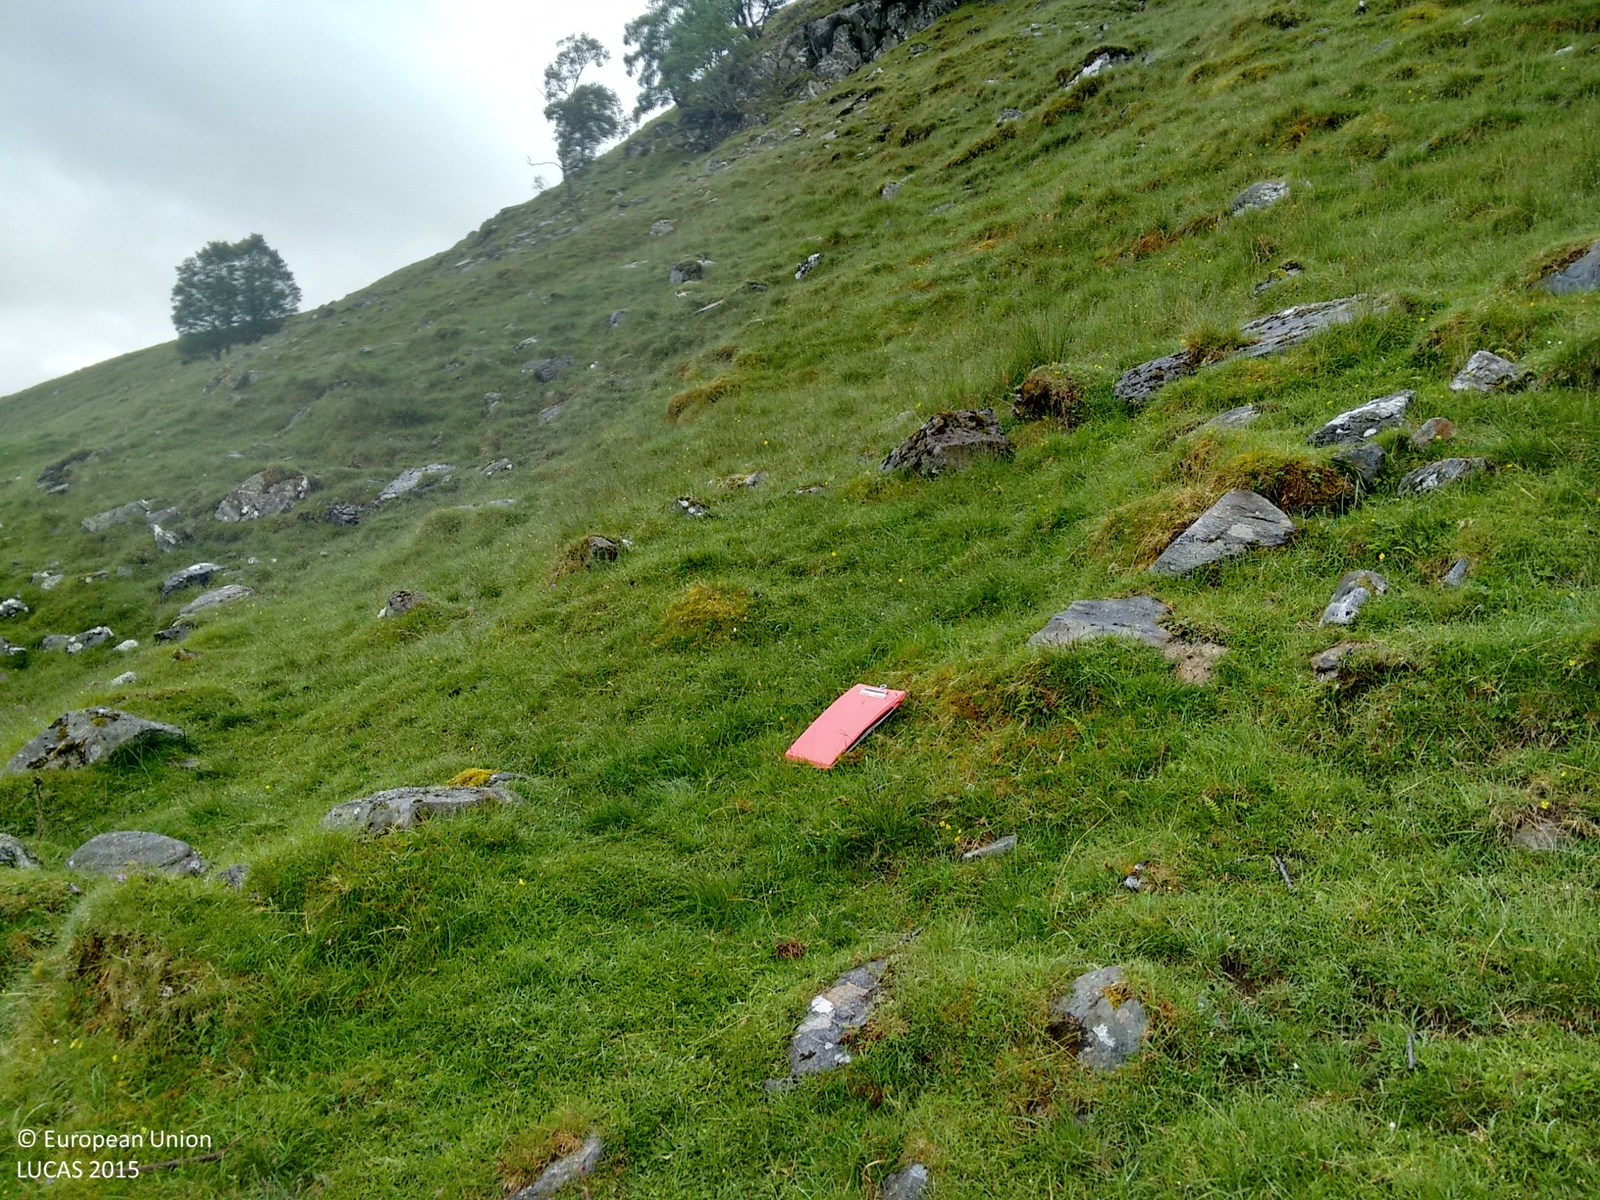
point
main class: Grassland
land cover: Grassland without tree/shrub cover
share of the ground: > 75 %
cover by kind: herbaceous plants 90 %, lichens and mosses 10 %
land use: Agriculture (excluding fallow land and kitchen gardens)
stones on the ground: < 10 %
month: July
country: GB
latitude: 56.5915
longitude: -4.2745
